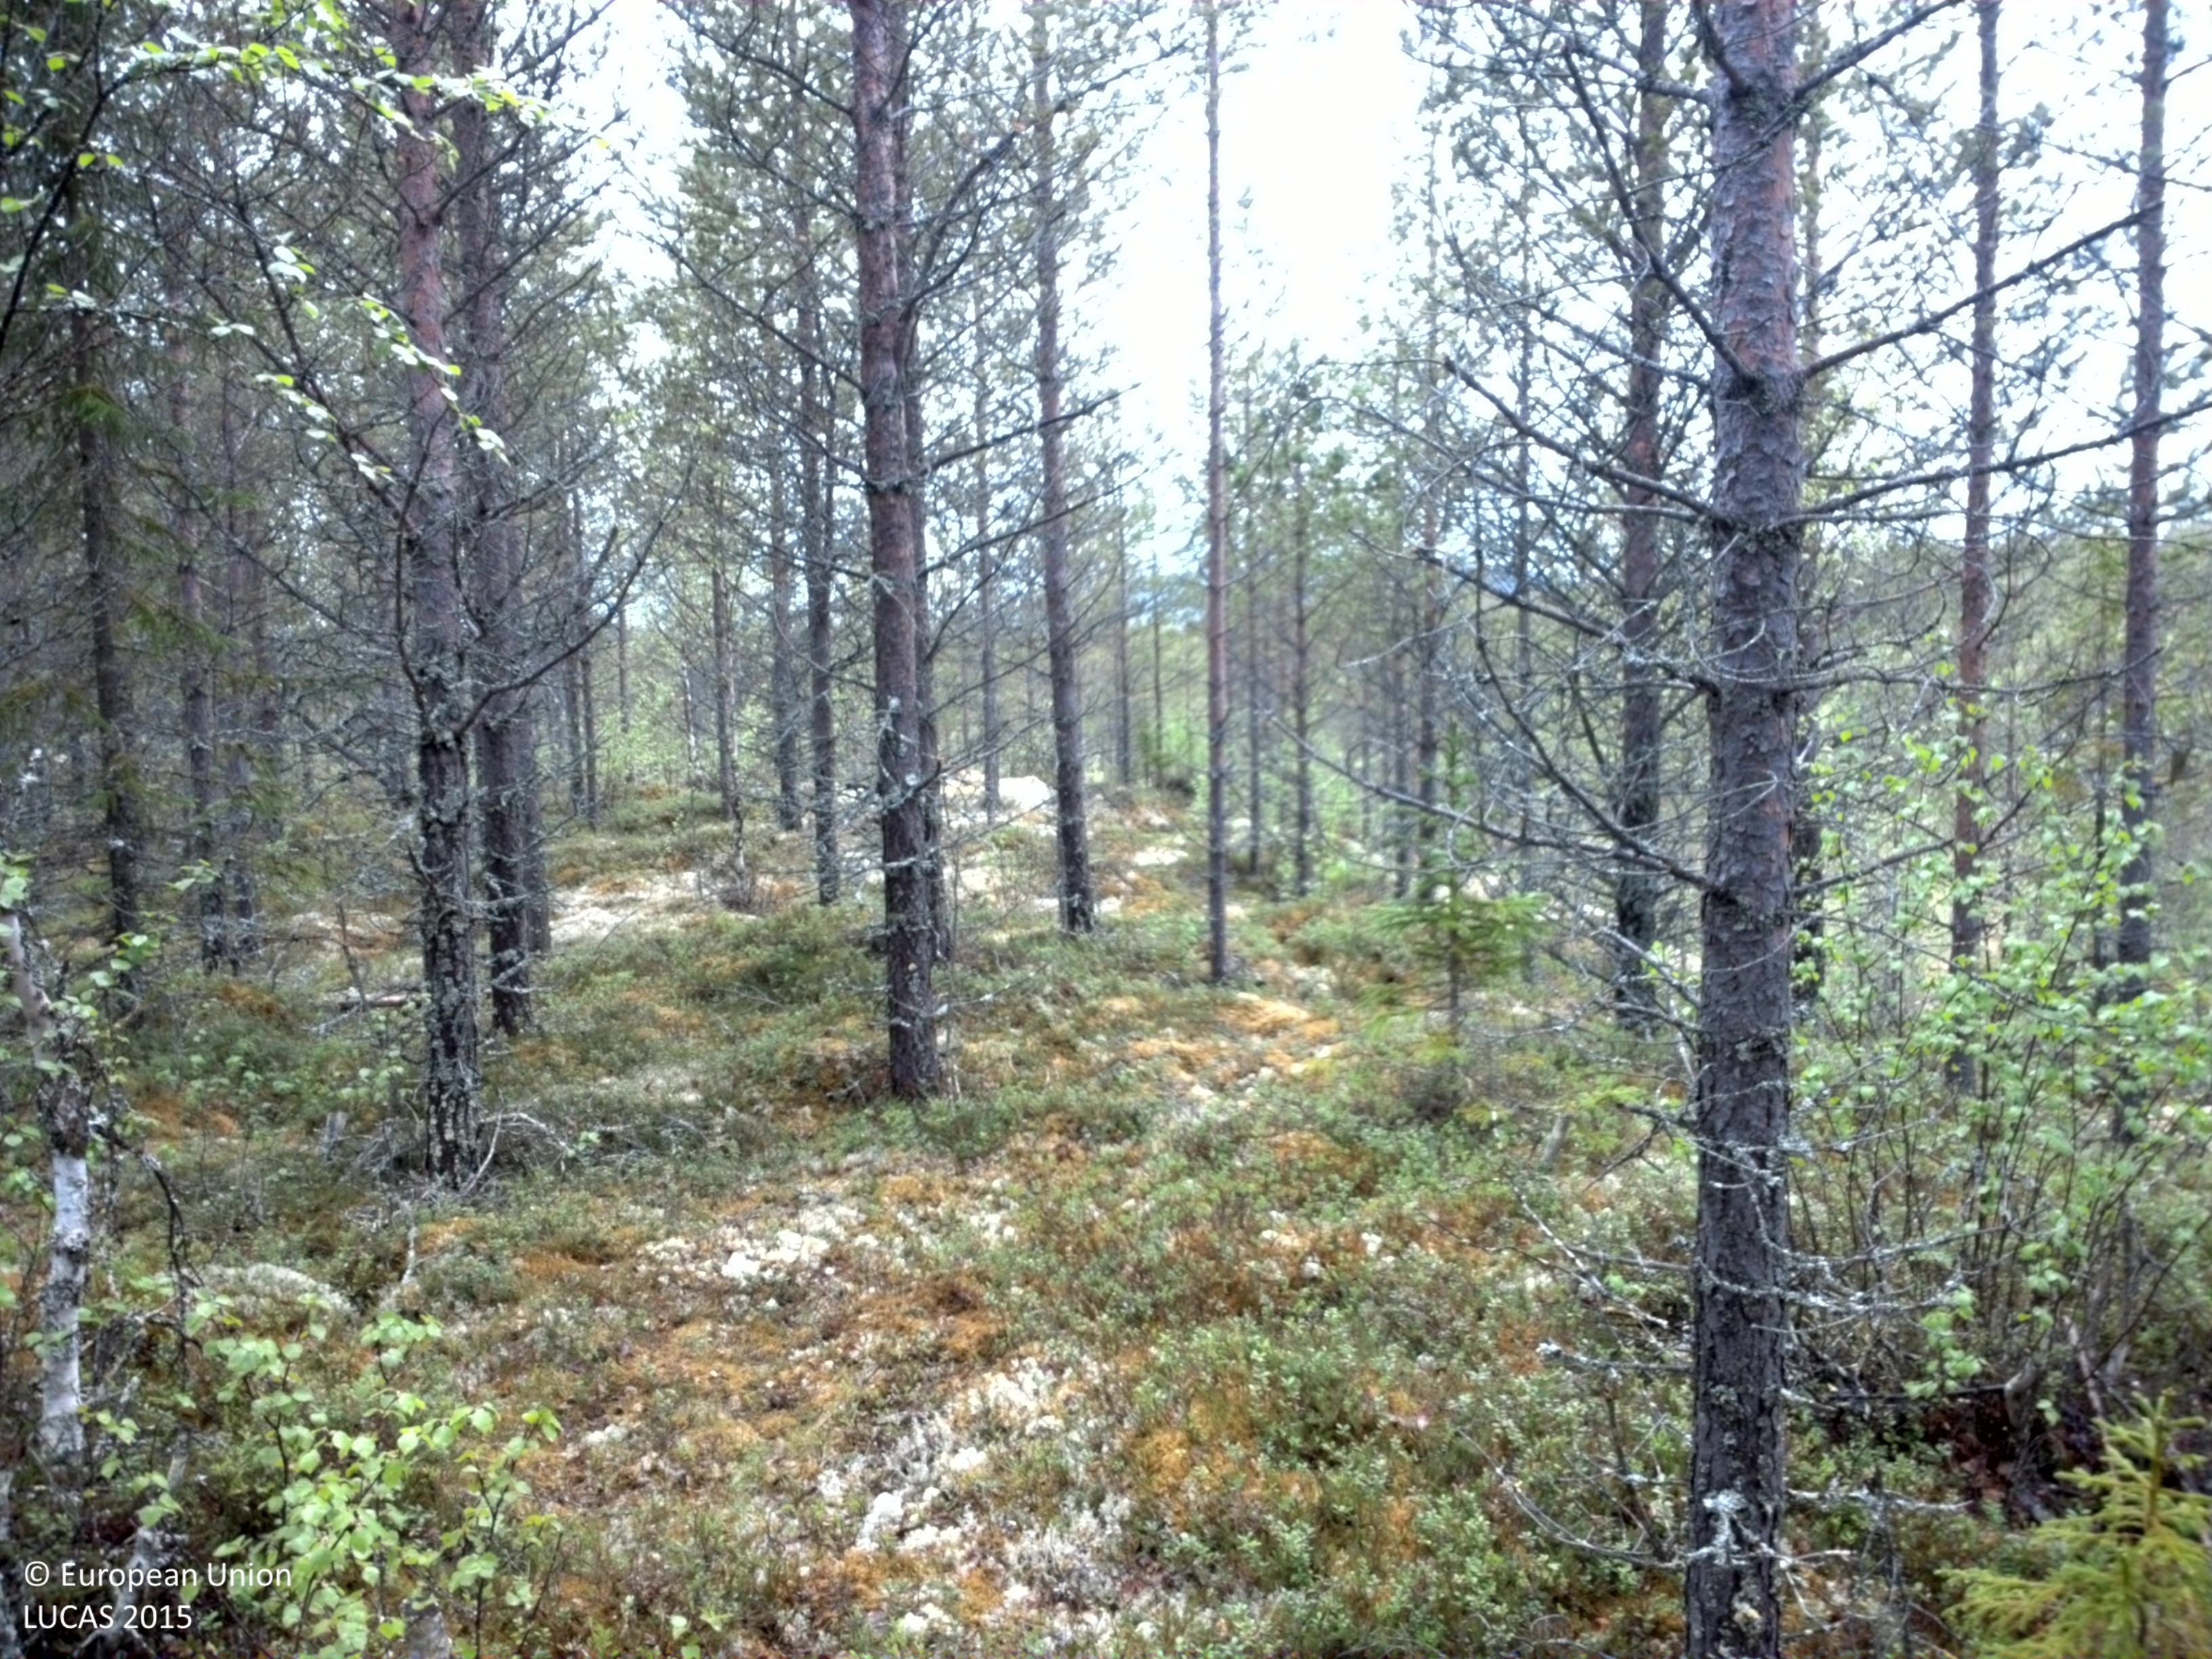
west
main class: Woodland
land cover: Pine dominated mixed woodland
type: boreal forest
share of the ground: 50 - 75 %
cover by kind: coniferous forest trees 40 %, shrubs 35 %, broadleaved forest trees 15 %, lichens and mosses 10 %
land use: Forestry
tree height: > 5 m
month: June
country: SE
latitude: 62.0640
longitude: 13.6018
